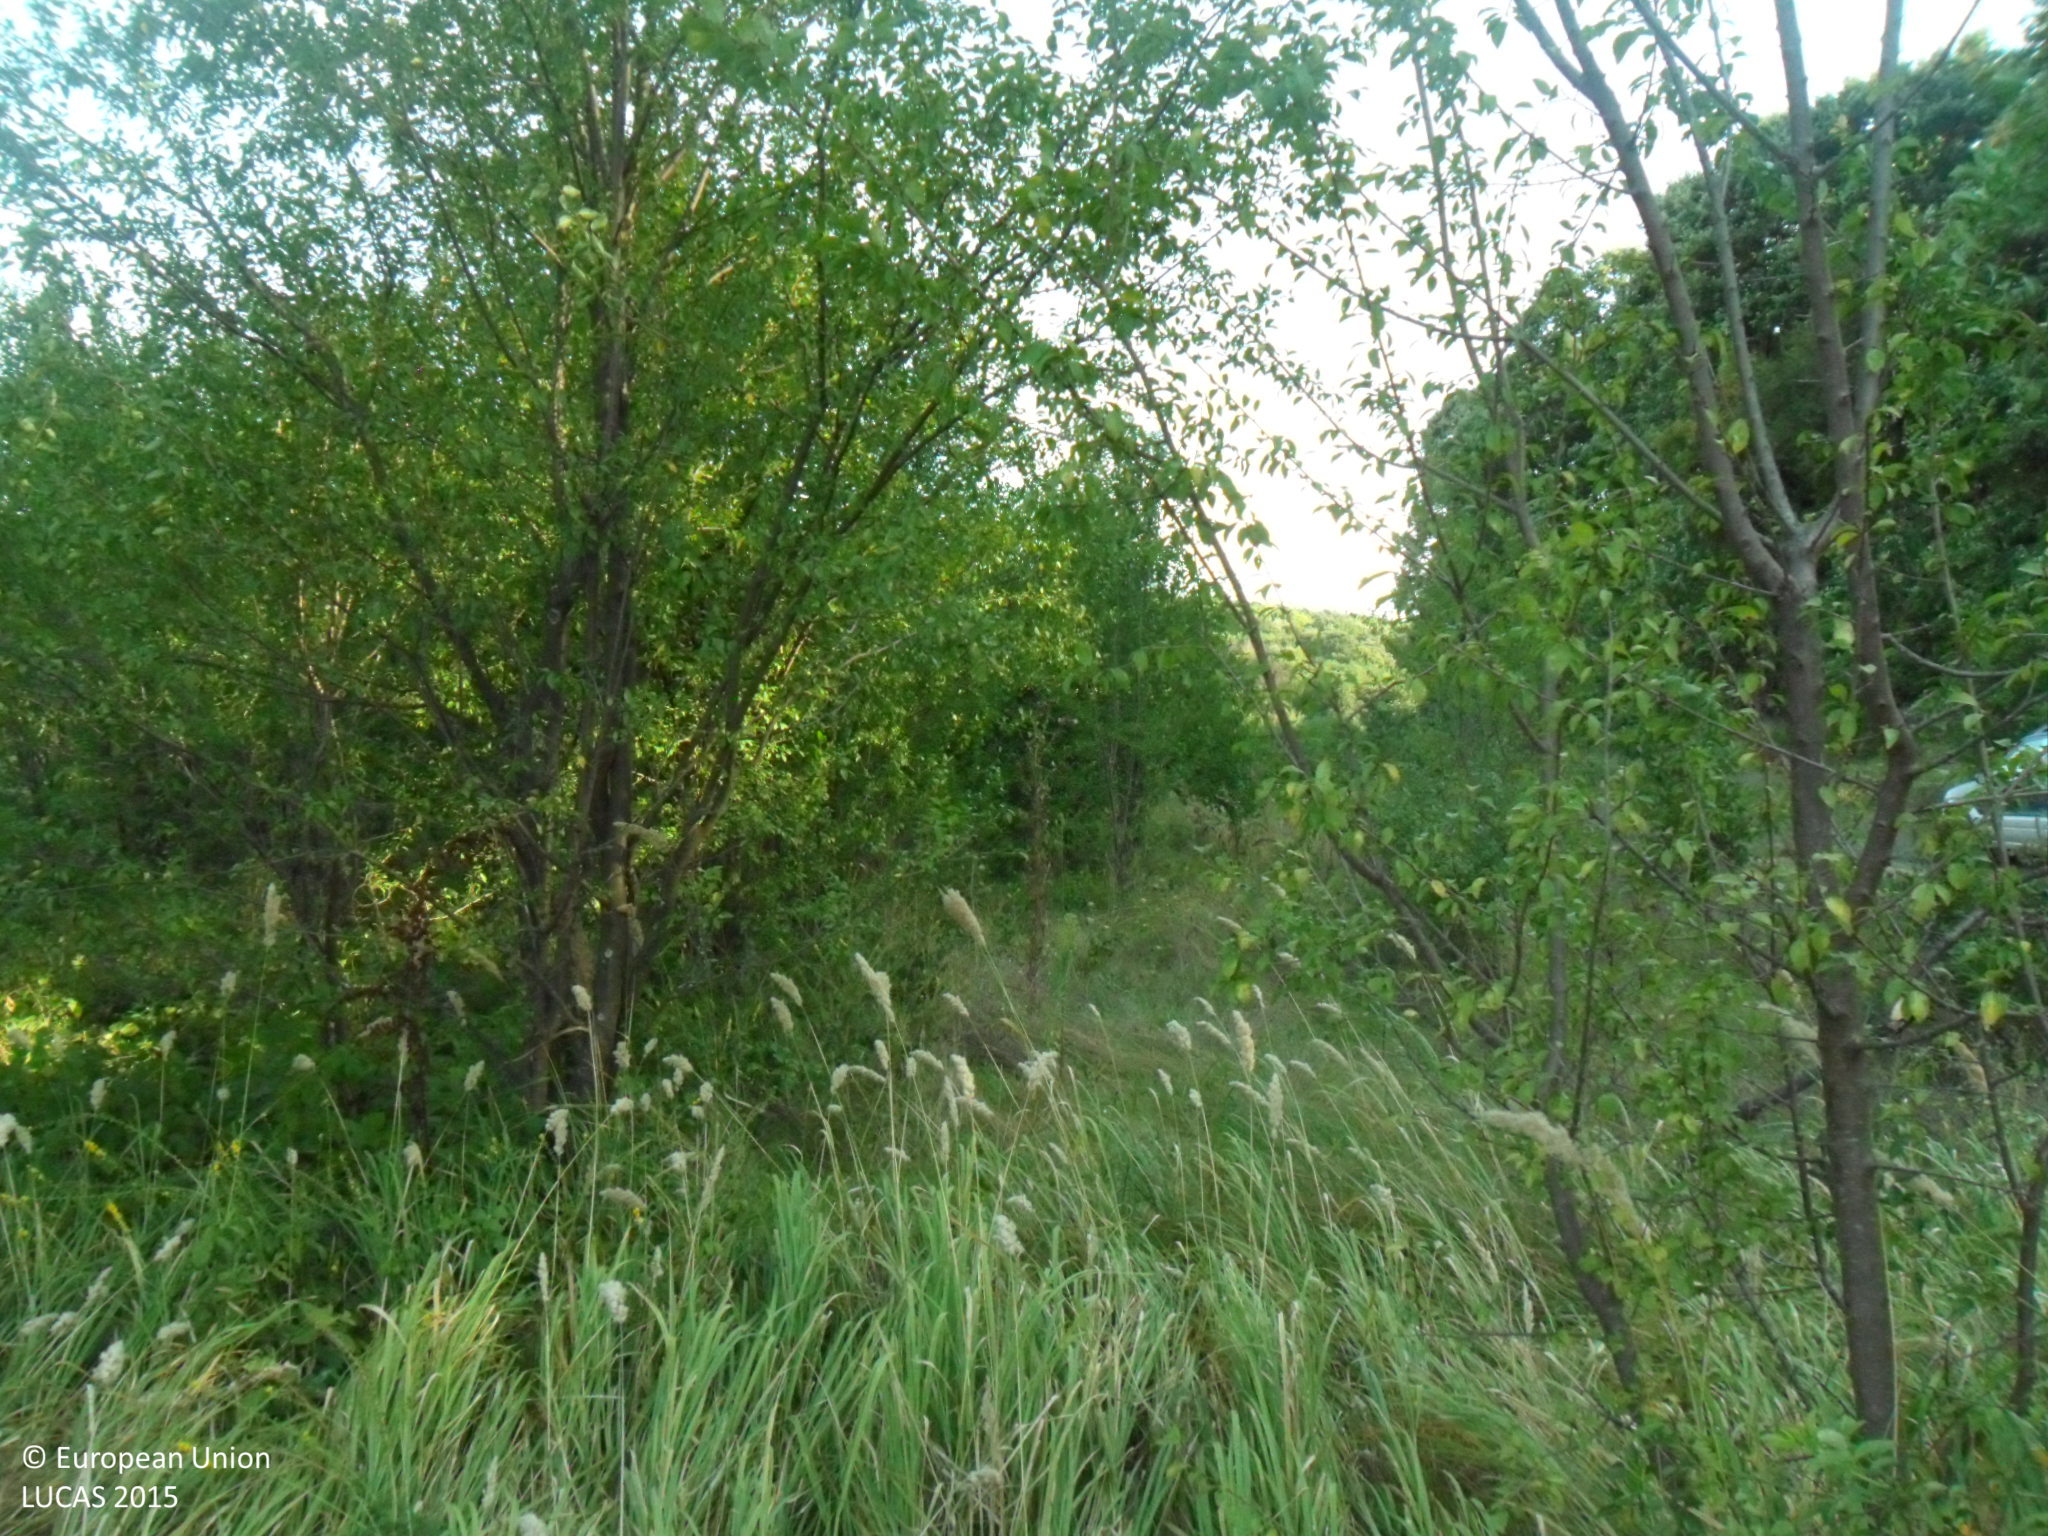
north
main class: Shrubland
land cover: Shrubland with sparse tree cover
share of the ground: > 75 %
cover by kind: shrubs 75 %, herbaceous plants 20 %, broadleaved forest trees 5 %
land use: Agriculture (excluding fallow land and kitchen gardens)
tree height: < 5 m
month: September
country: BG
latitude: 43.6211
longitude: 26.2978
